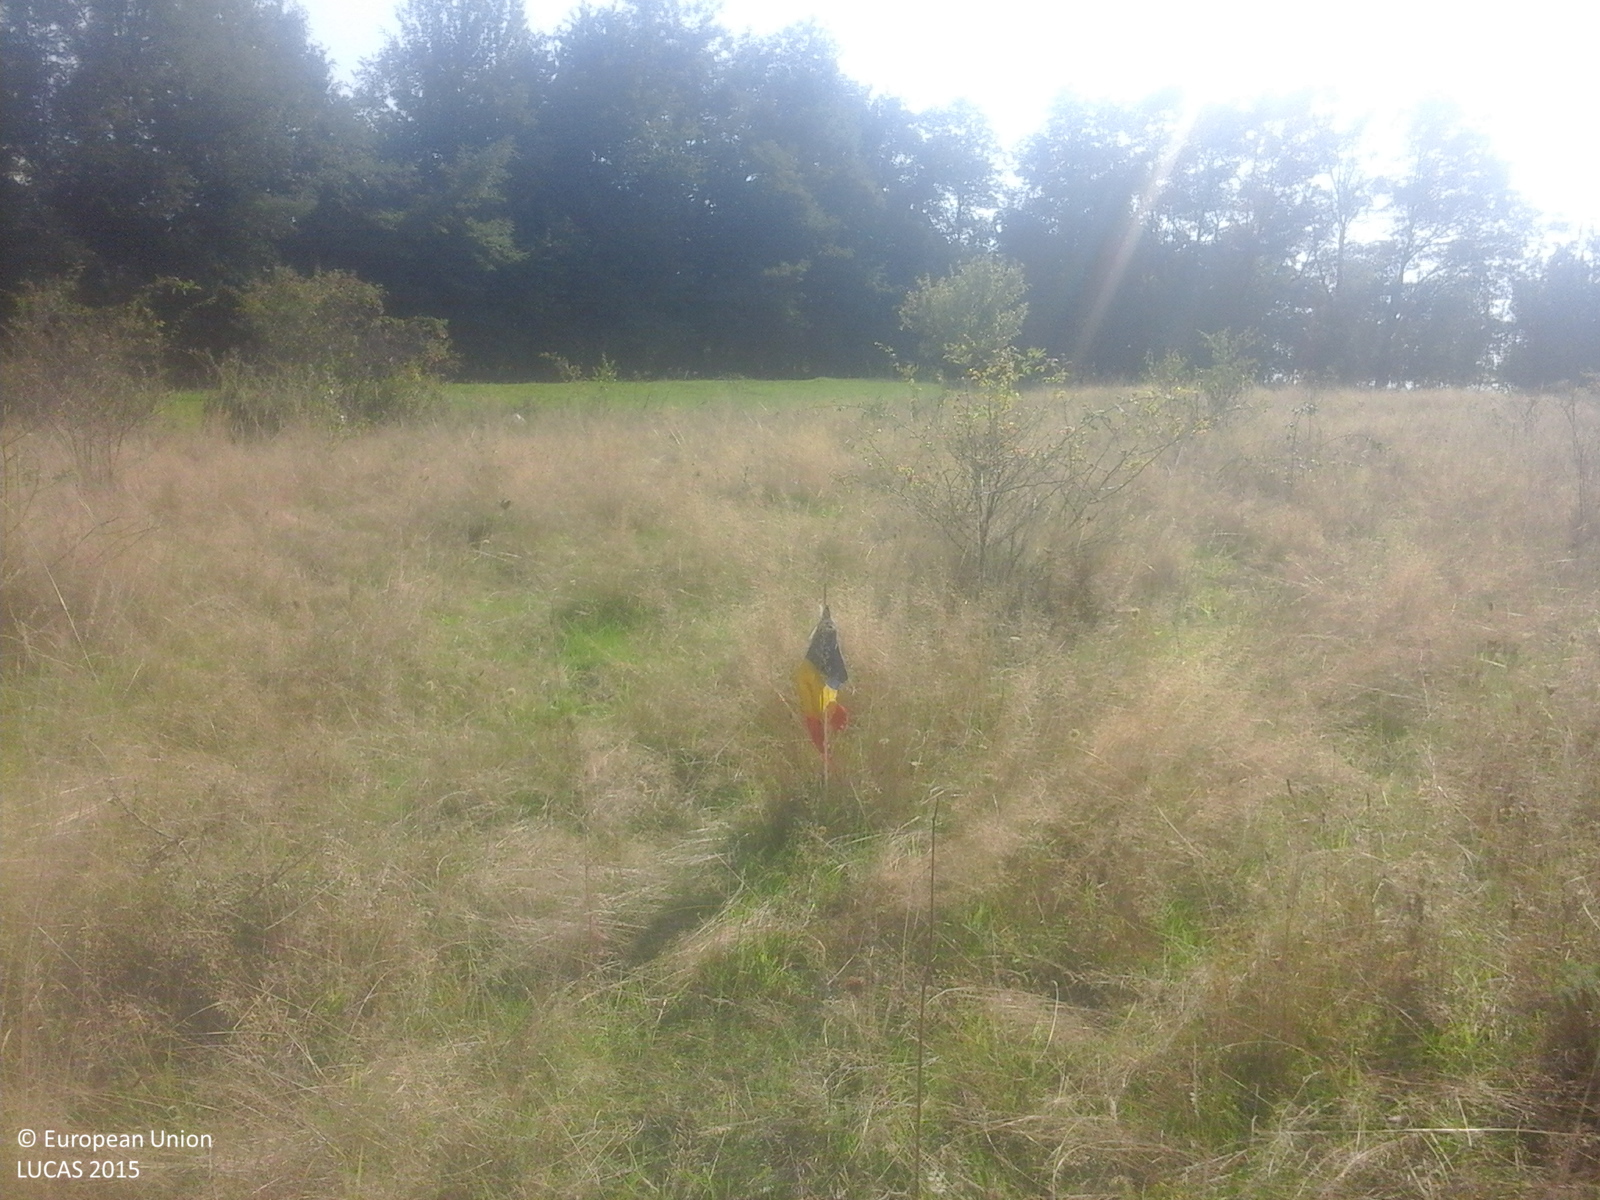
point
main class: Grassland
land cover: Grassland with sparse tree/shrub cover
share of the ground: > 75 %
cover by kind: herbaceous plants 85 %, shrubs 10 %, broadleaved forest trees 5 %
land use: Agriculture (excluding fallow land and kitchen gardens)
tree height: < 5 m
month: September
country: RO
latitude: 45.8514
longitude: 22.5006
